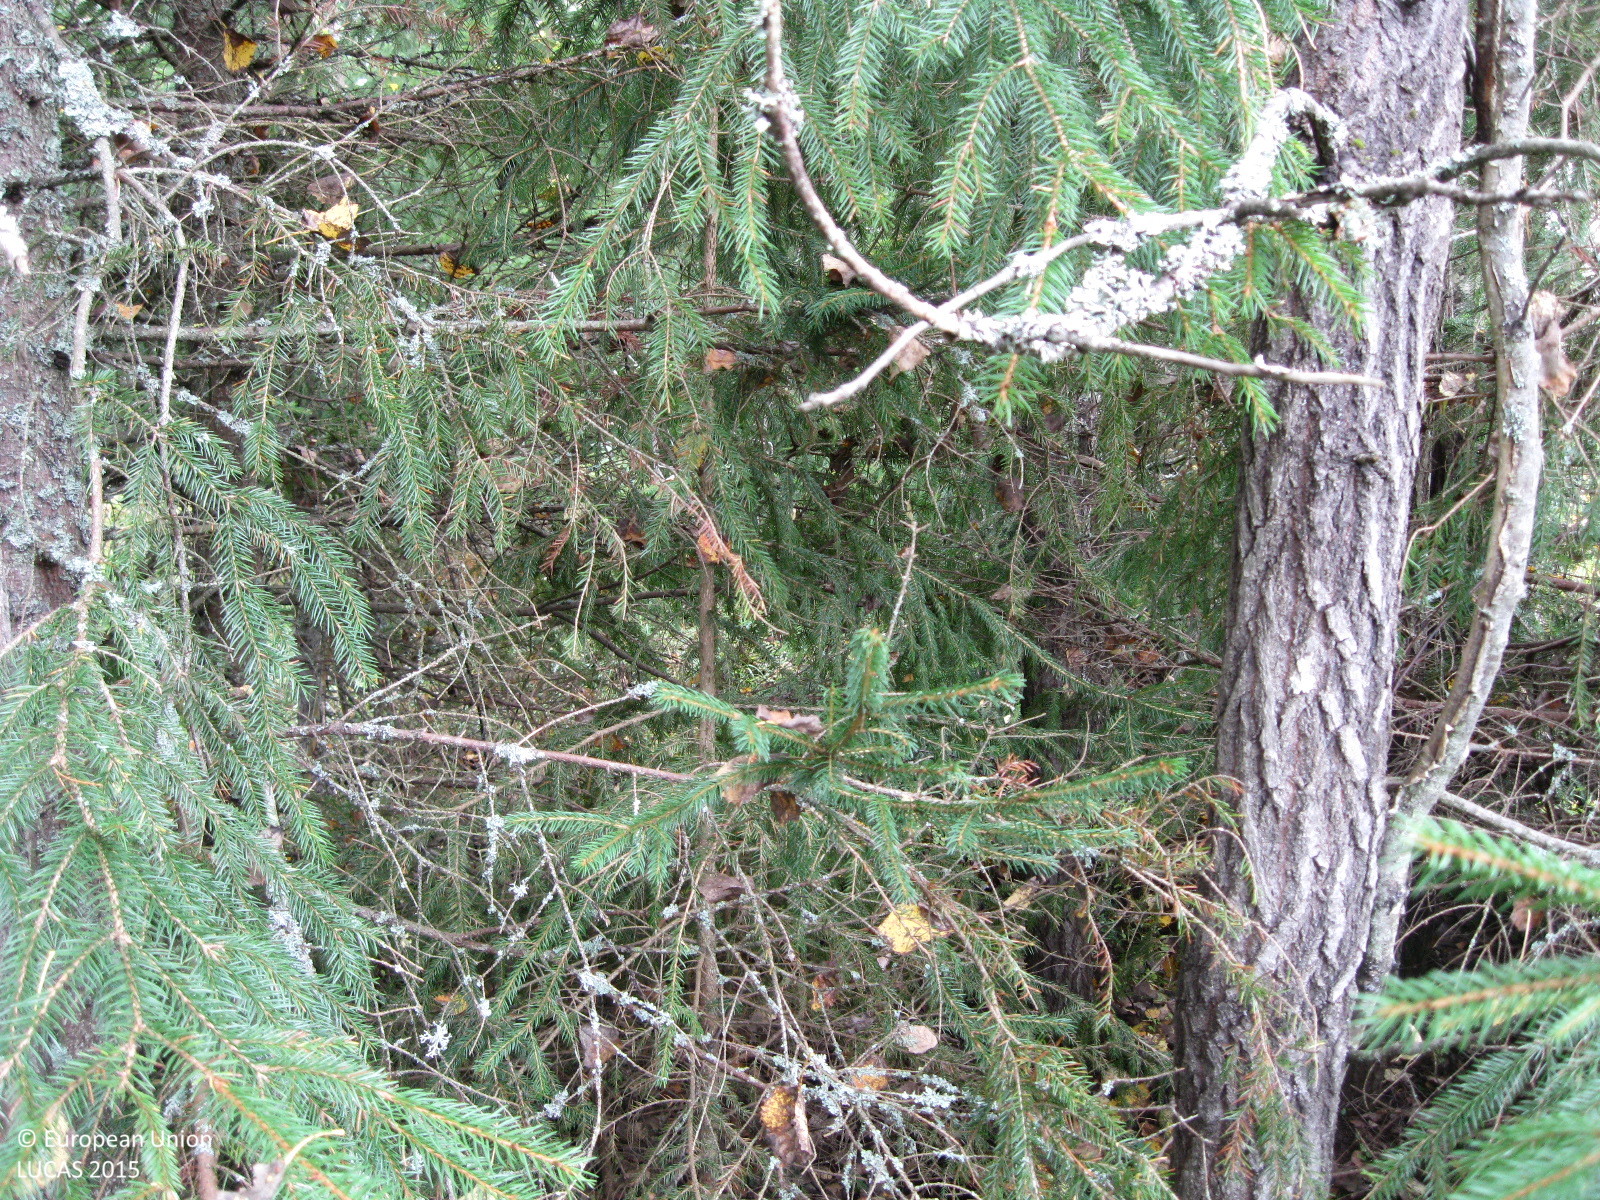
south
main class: Woodland
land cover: Spruce dominated mixed woodland
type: boreal forest
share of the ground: 25 - 50 %
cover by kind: shrubs 35 %, coniferous forest trees 30 %, herbaceous plants 20 %, broadleaved forest trees 15 %
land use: Forestry
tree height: > 5 m
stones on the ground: 25 - 50 %
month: September
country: FI
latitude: 60.4698
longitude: 24.1593
